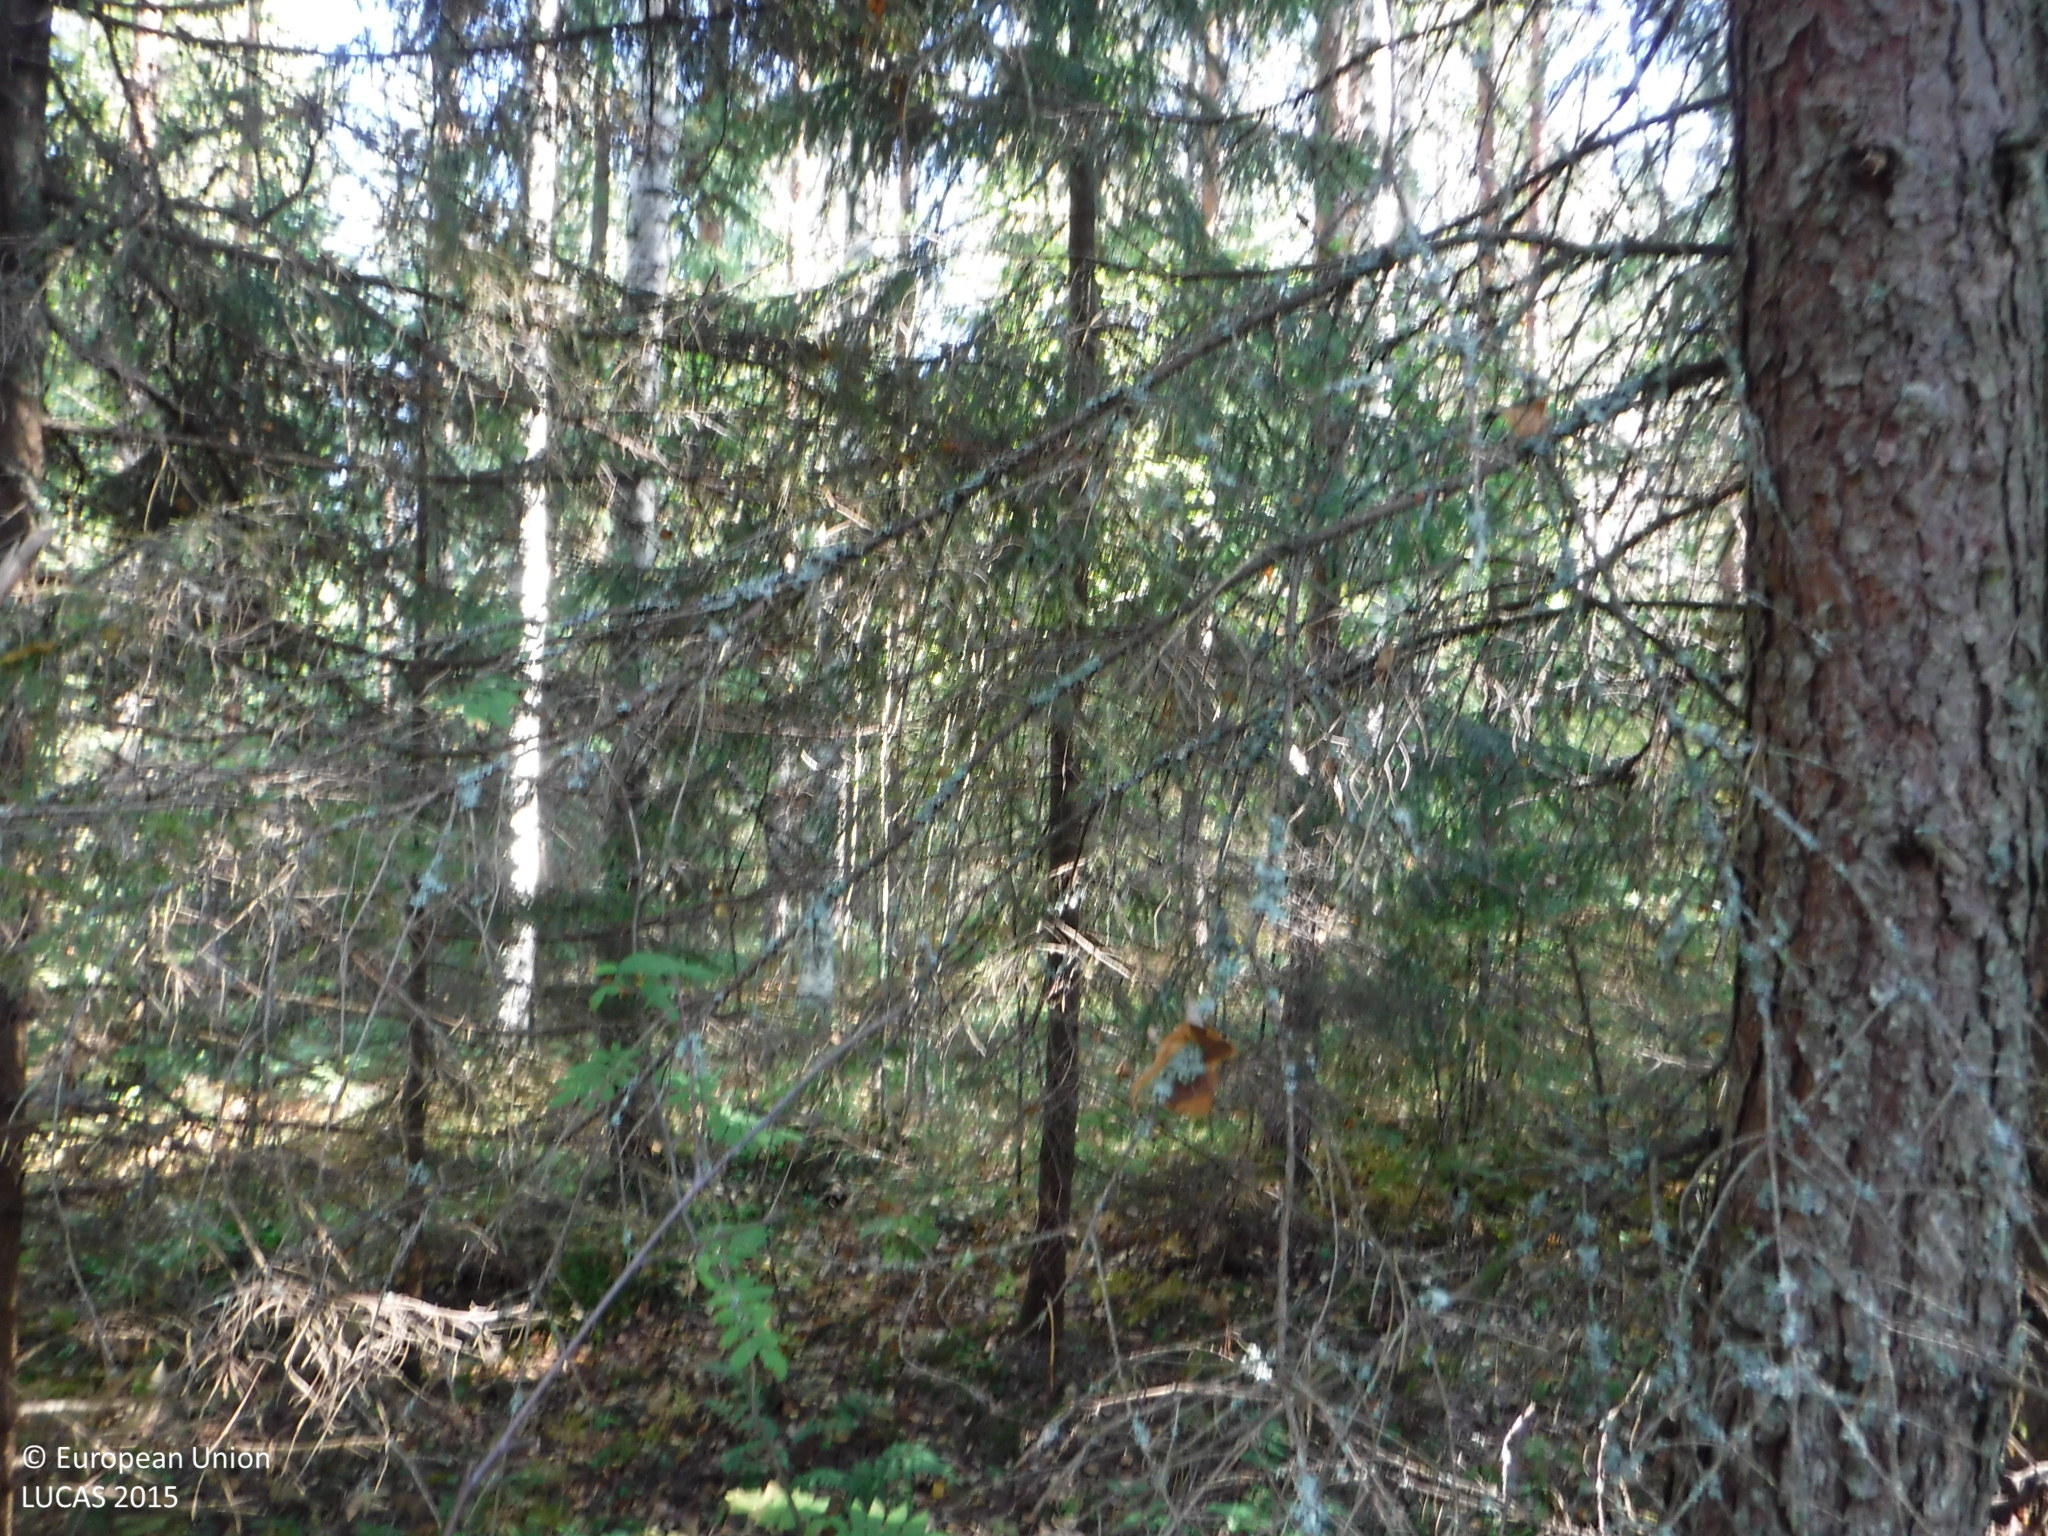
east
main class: Woodland
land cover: Other mixed woodland
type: boreal forest
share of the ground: 50 - 75 %
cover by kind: coniferous forest trees 40 %, broadleaved forest trees 30 %, lichens and mosses 25 %, herbaceous plants 5 %
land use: Forestry
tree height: > 5 m
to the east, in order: Other mixed woodland; Broadleaved woodland; Rivers and streams; Broadleaved woodland; Inland marshes; Inland fresh water bodies; Inland marshes; Grassland without tree/shrub cover
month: September
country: FI
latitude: 61.7961
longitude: 22.7155
